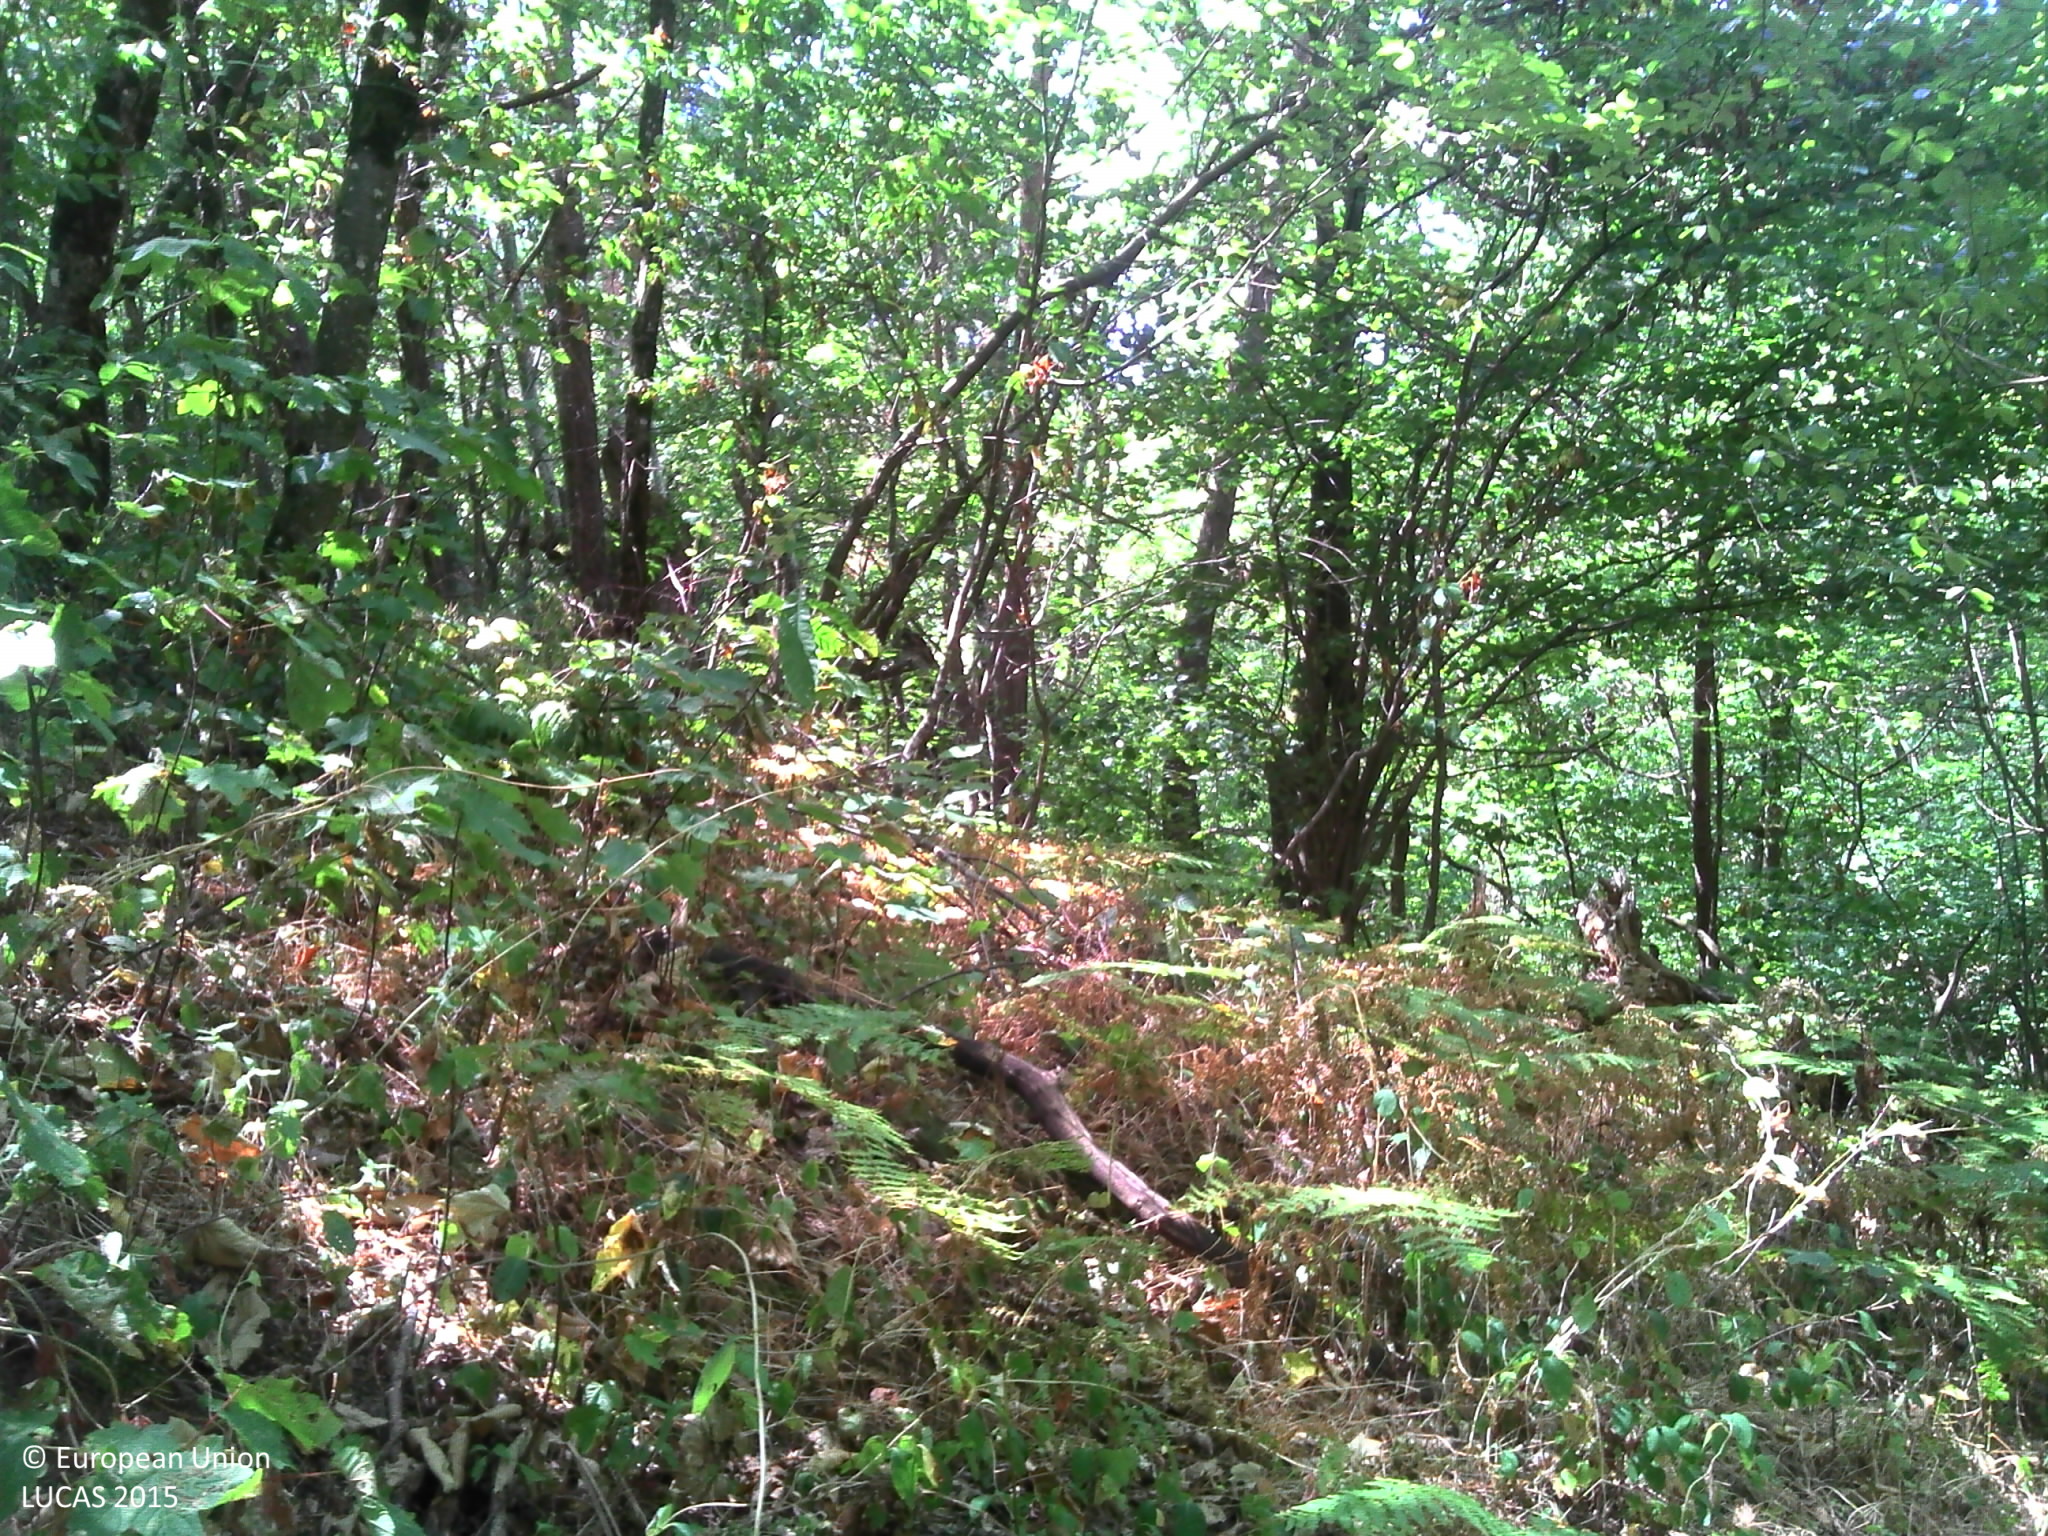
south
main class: Woodland
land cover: Broadleaved woodland
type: broadleaved evergreen forest
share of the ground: > 75 %
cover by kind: broadleaved forest trees 100 %
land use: Forestry
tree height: > 5 m
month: July
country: FR
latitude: 44.9710
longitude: 4.6420
